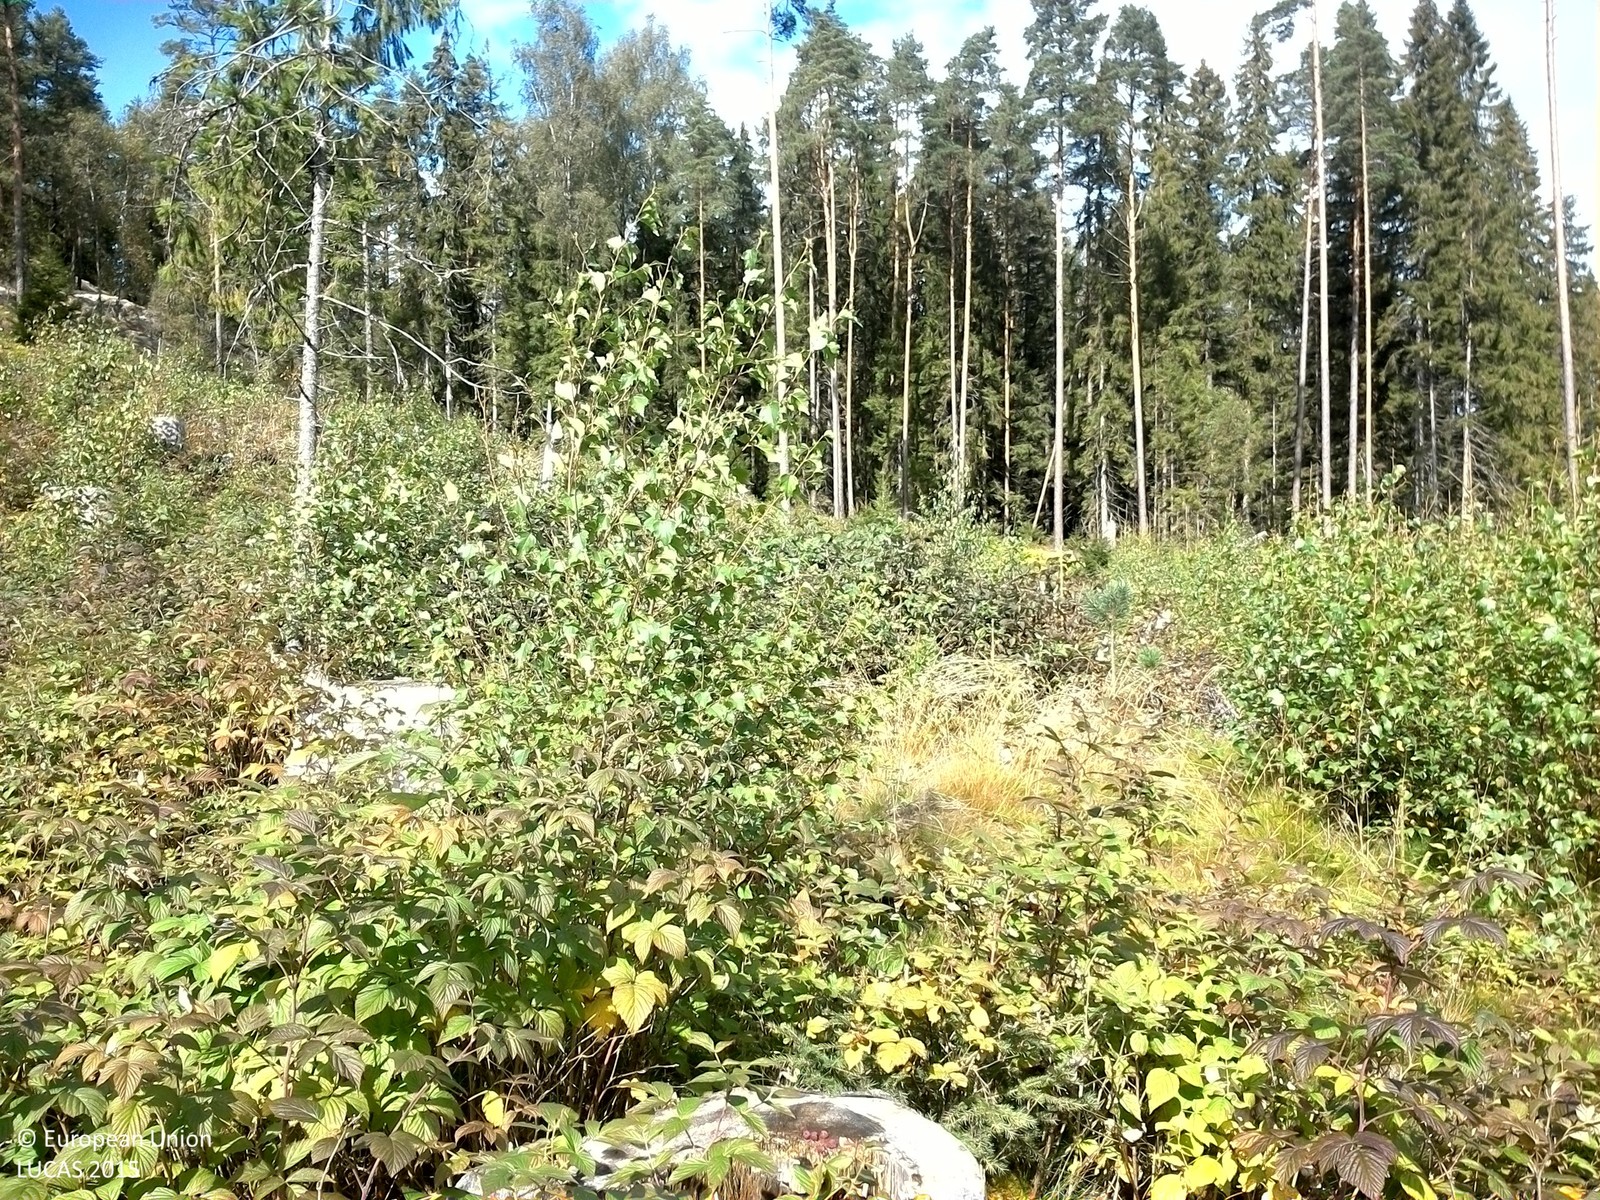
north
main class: Woodland
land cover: Spruce dominated mixed woodland
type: boreal forest
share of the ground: 25 - 50 %
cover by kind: broadleaved forest trees 30 %, shrubs 30 %, coniferous forest trees 20 %, herbaceous plants 10 %, consolidated bare surface 10 %
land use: Forestry
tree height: < 5 m
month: September
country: SE
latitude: 59.3206
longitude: 11.9805
